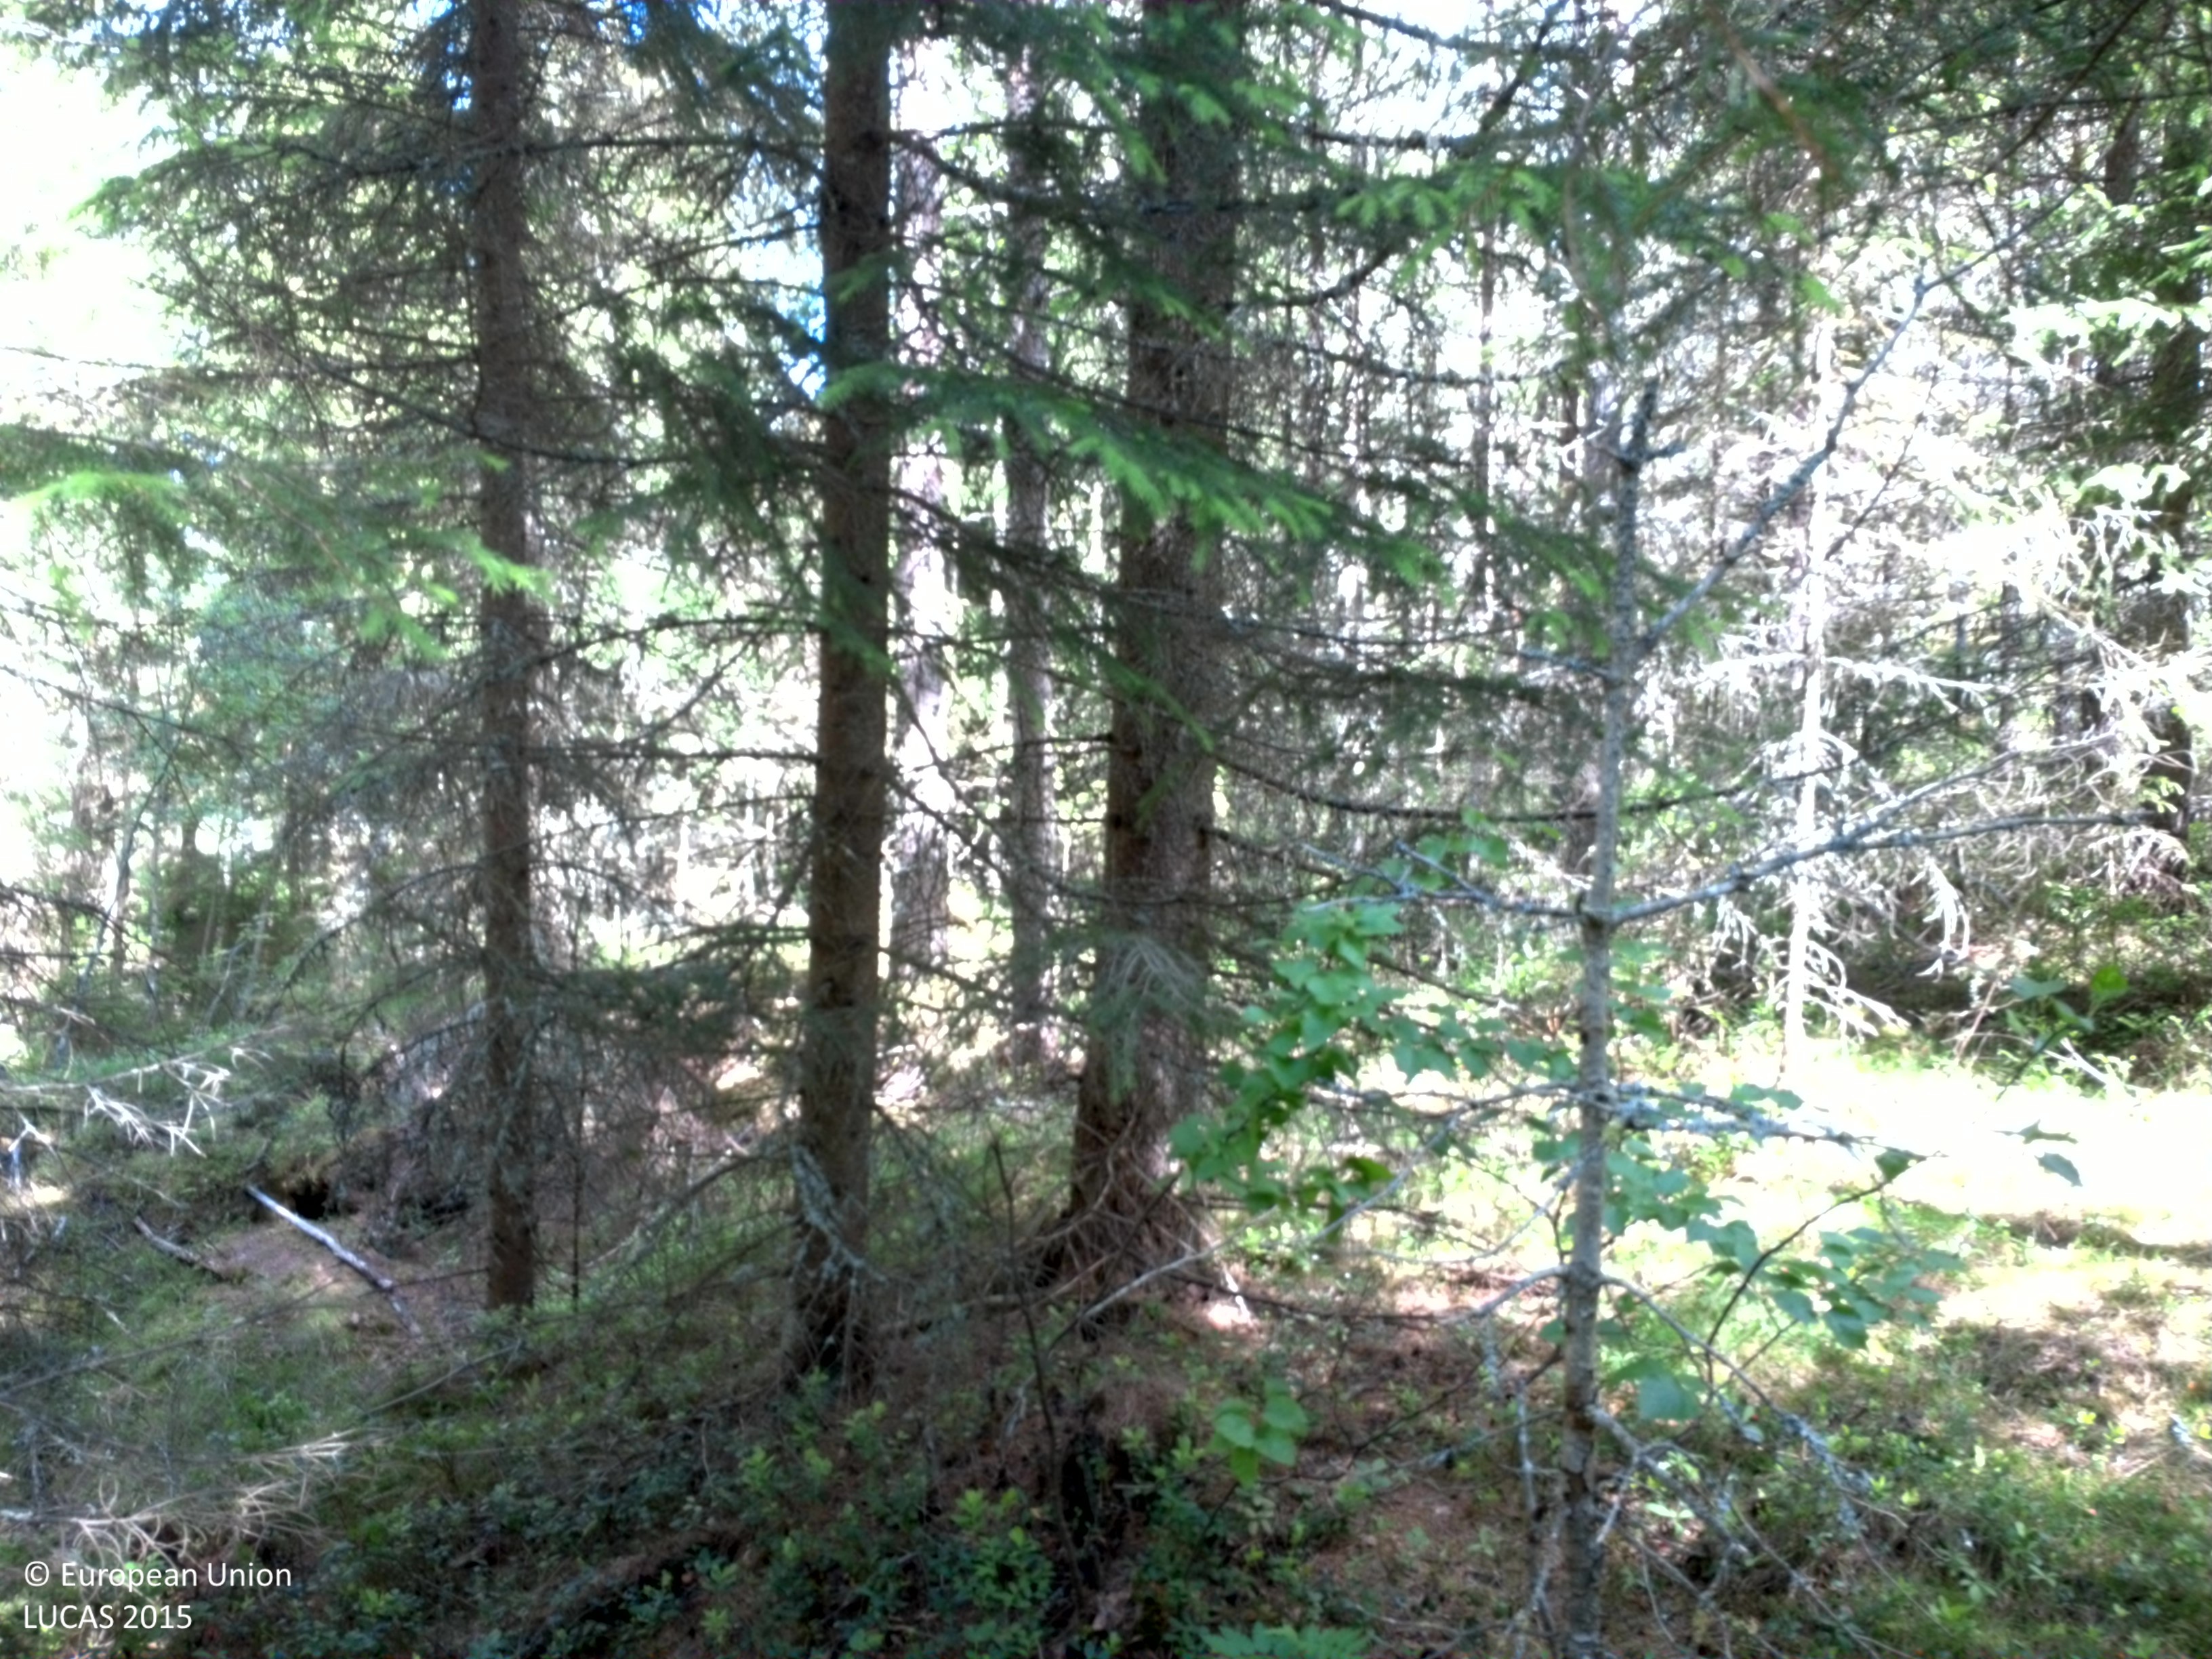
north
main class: Woodland
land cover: Spruce dominated coniferous woodland
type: boreal forest
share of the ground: 50 - 75 %
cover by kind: coniferous forest trees 75 %, shrubs 20 %, herbaceous plants 5 %
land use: Forestry
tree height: > 5 m
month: July
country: SE
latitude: 64.3005
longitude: 20.8322
